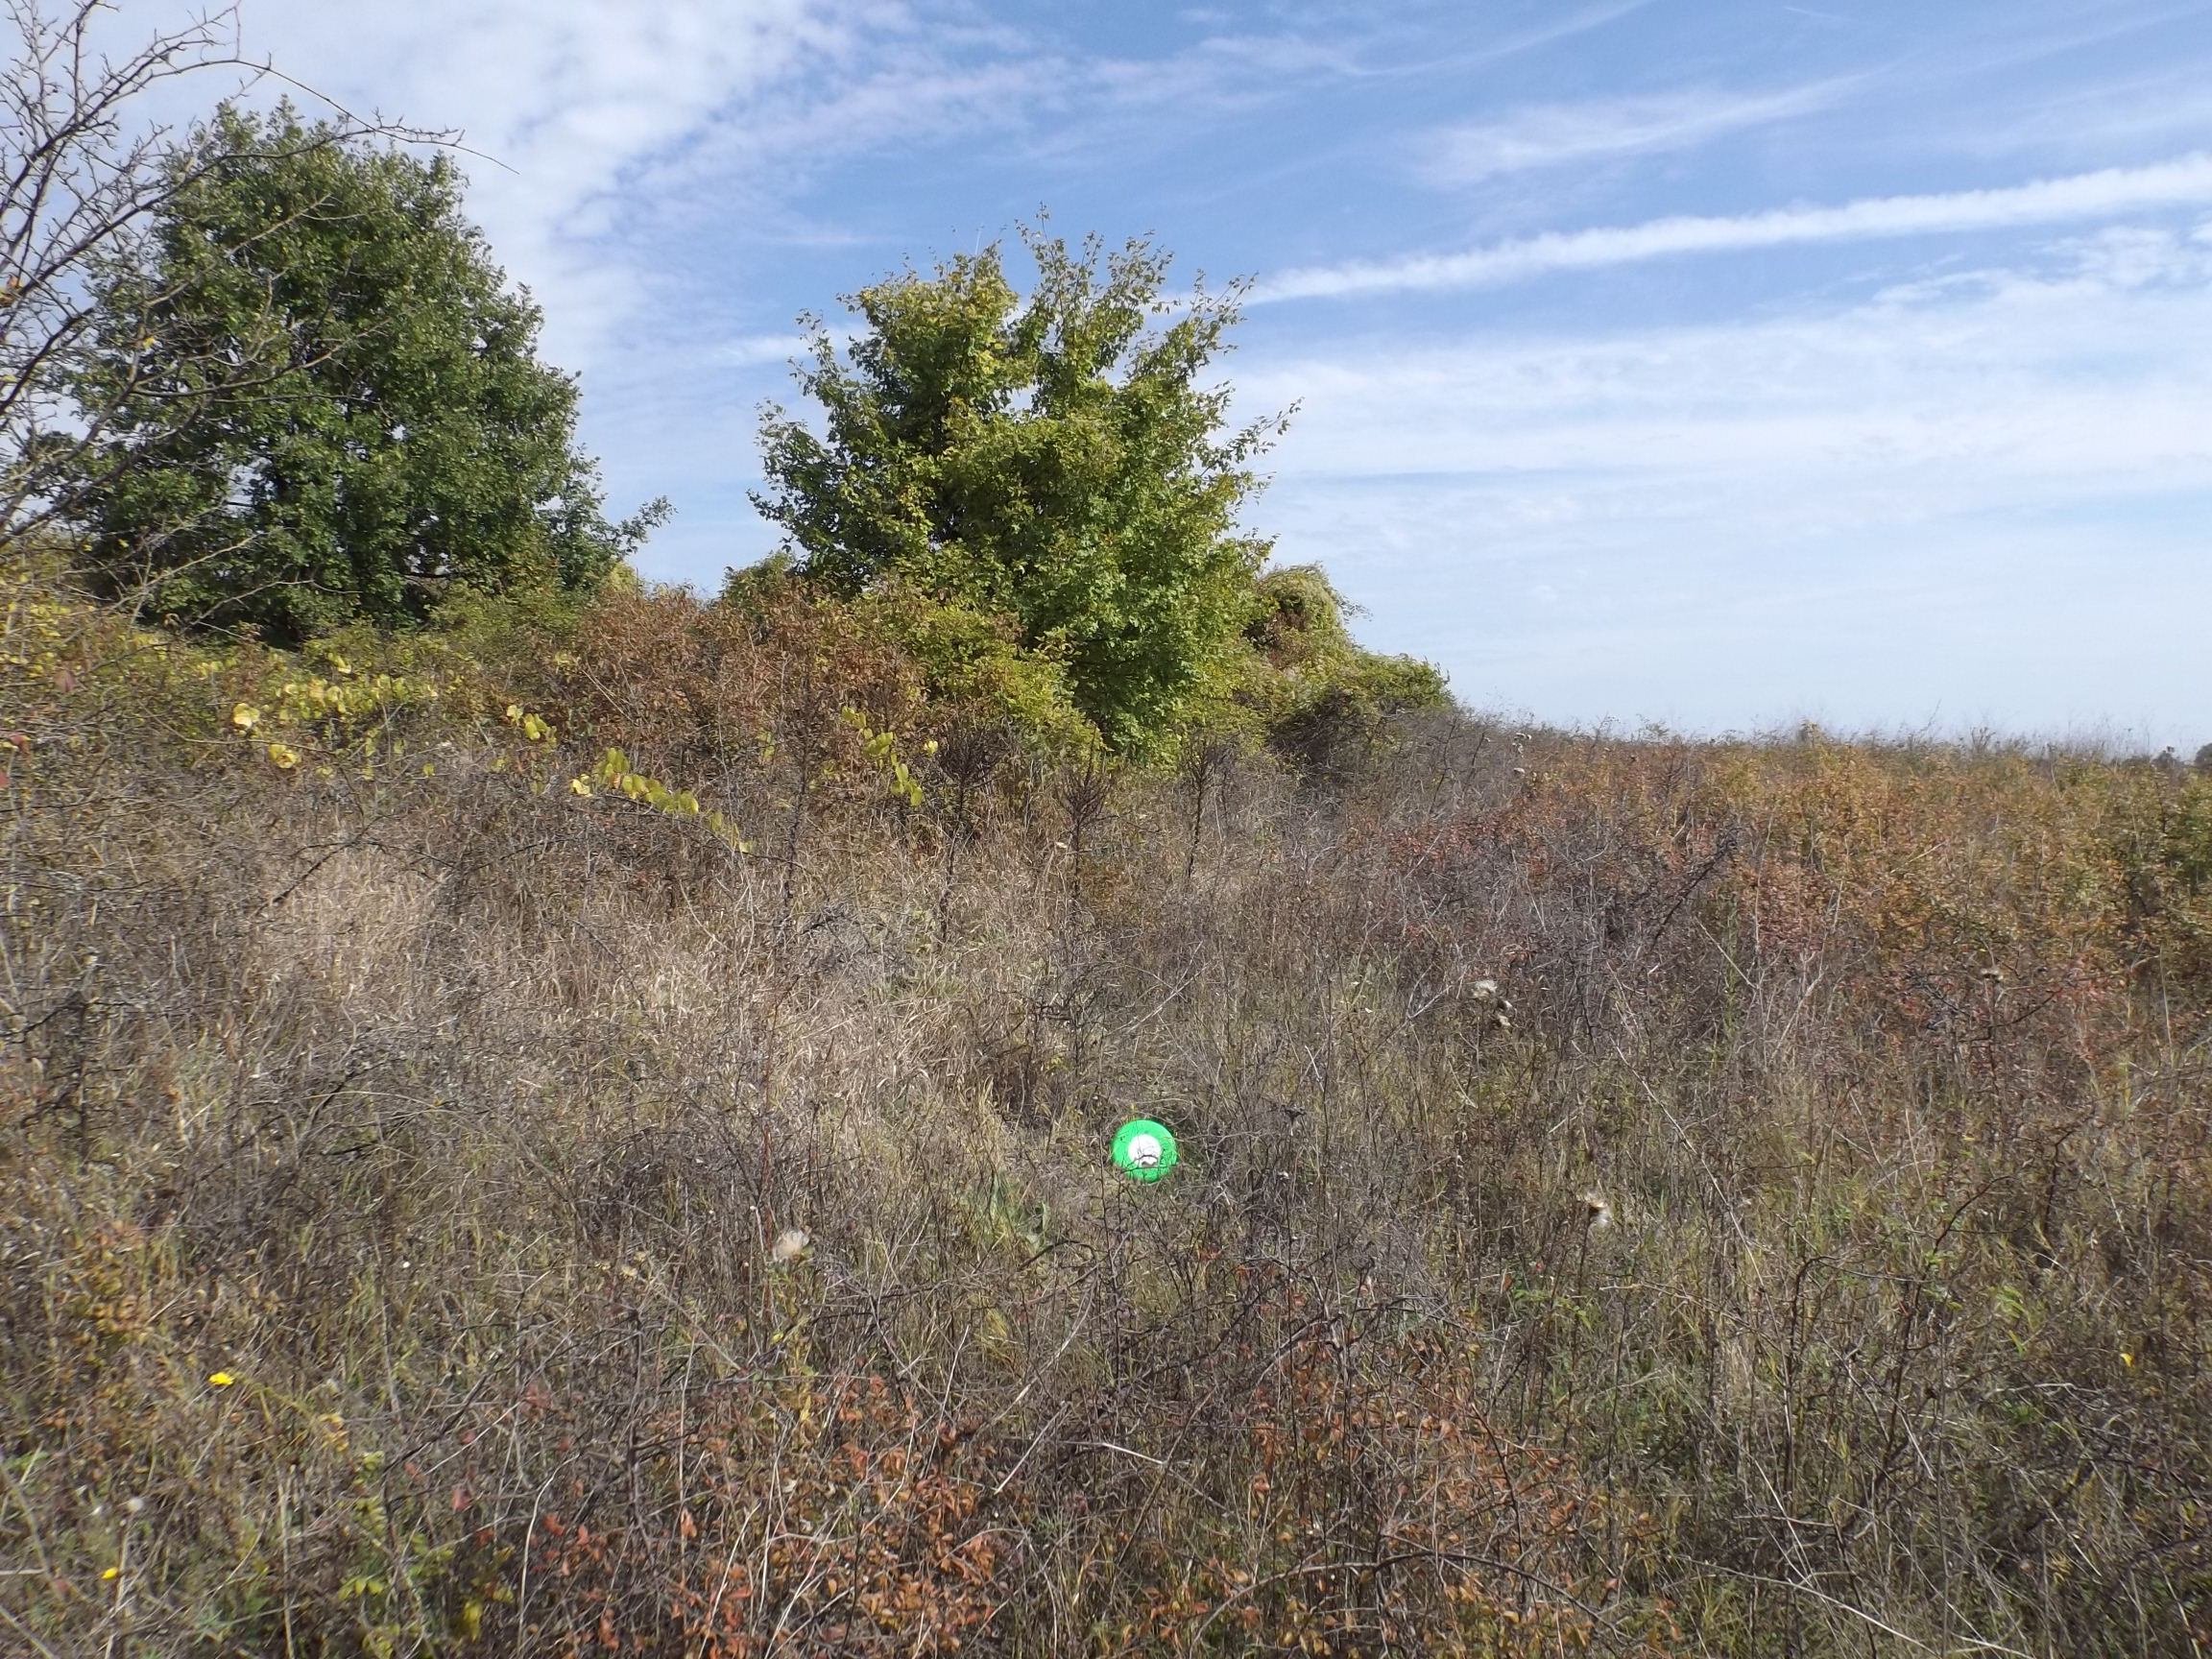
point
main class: Shrubland
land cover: Shrubland with sparse tree cover
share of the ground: > 75 %
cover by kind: shrubs 90 %, broadleaved forest trees 5 %, herbaceous plants 5 %
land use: Semi-natural and natural areas not in use
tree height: < 5 m
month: October
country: BG
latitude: 43.1196
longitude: 27.2146
